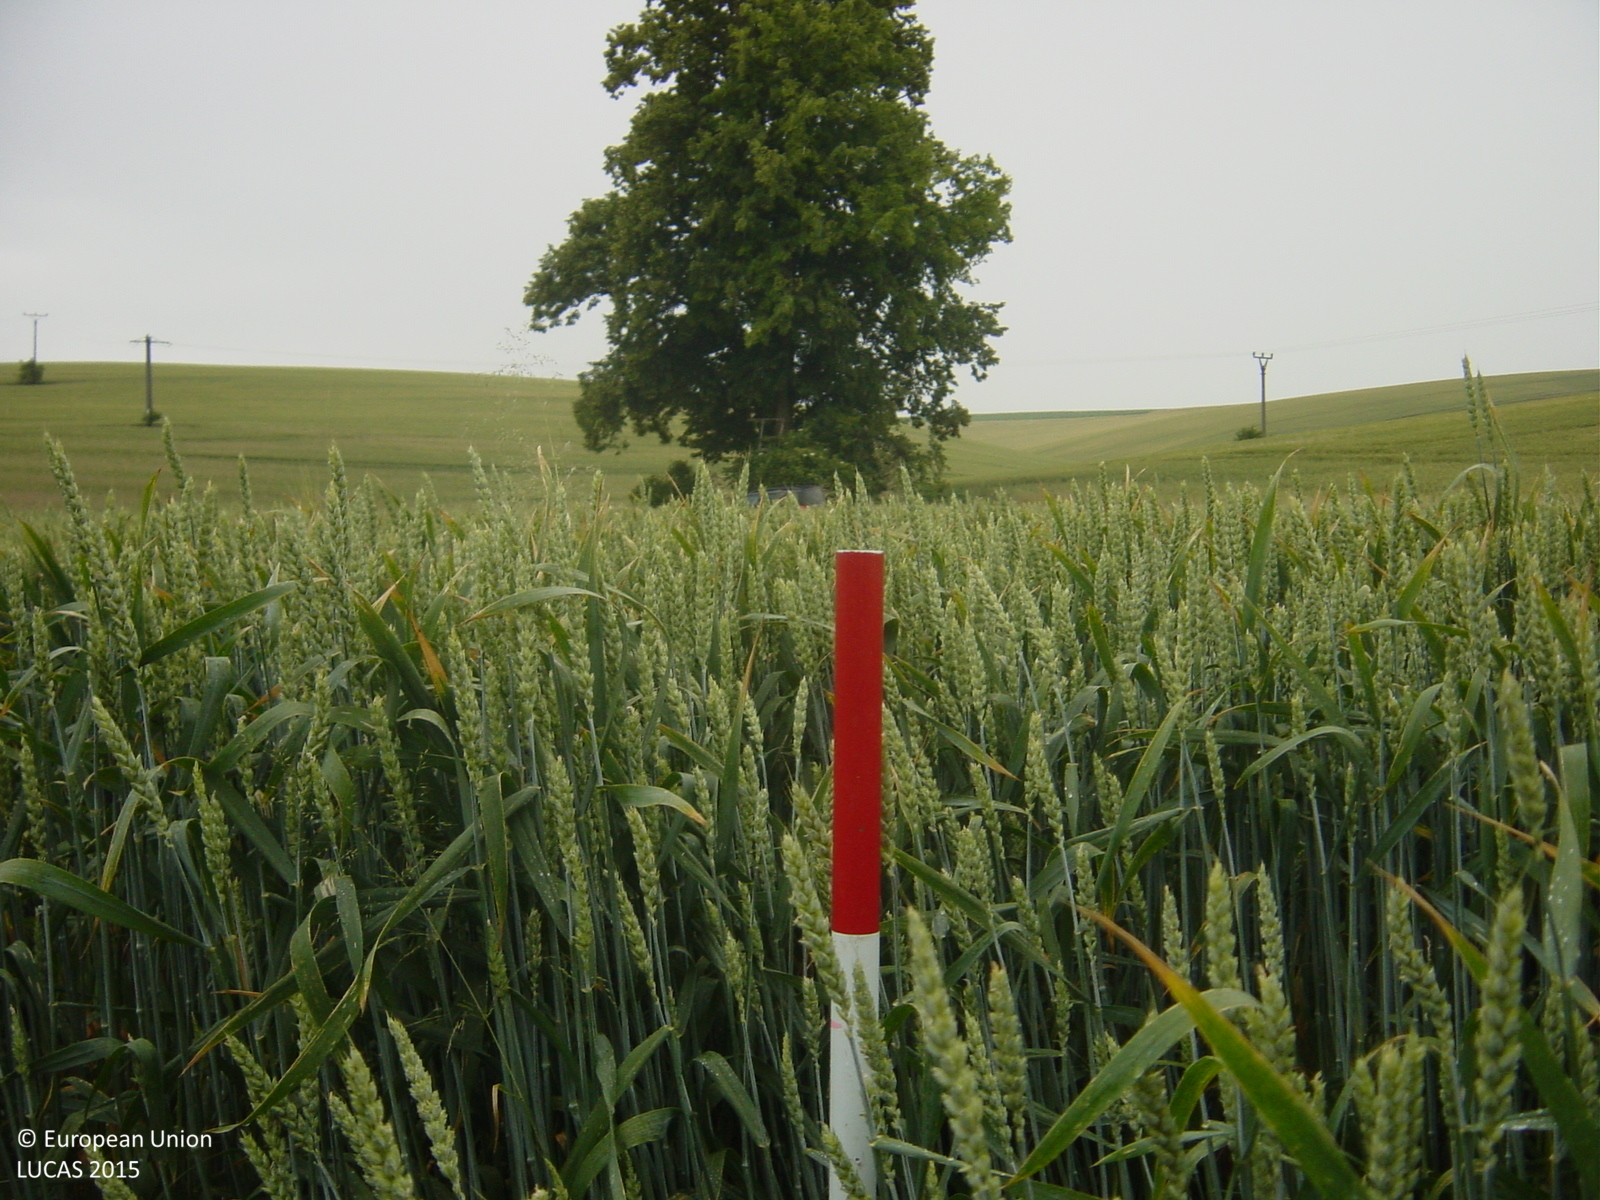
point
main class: Cropland
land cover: Common wheat
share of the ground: > 75 %
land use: Agriculture (excluding fallow land and kitchen gardens)
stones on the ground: < 10 %
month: June
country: CZ
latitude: 48.9392
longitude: 17.0125
